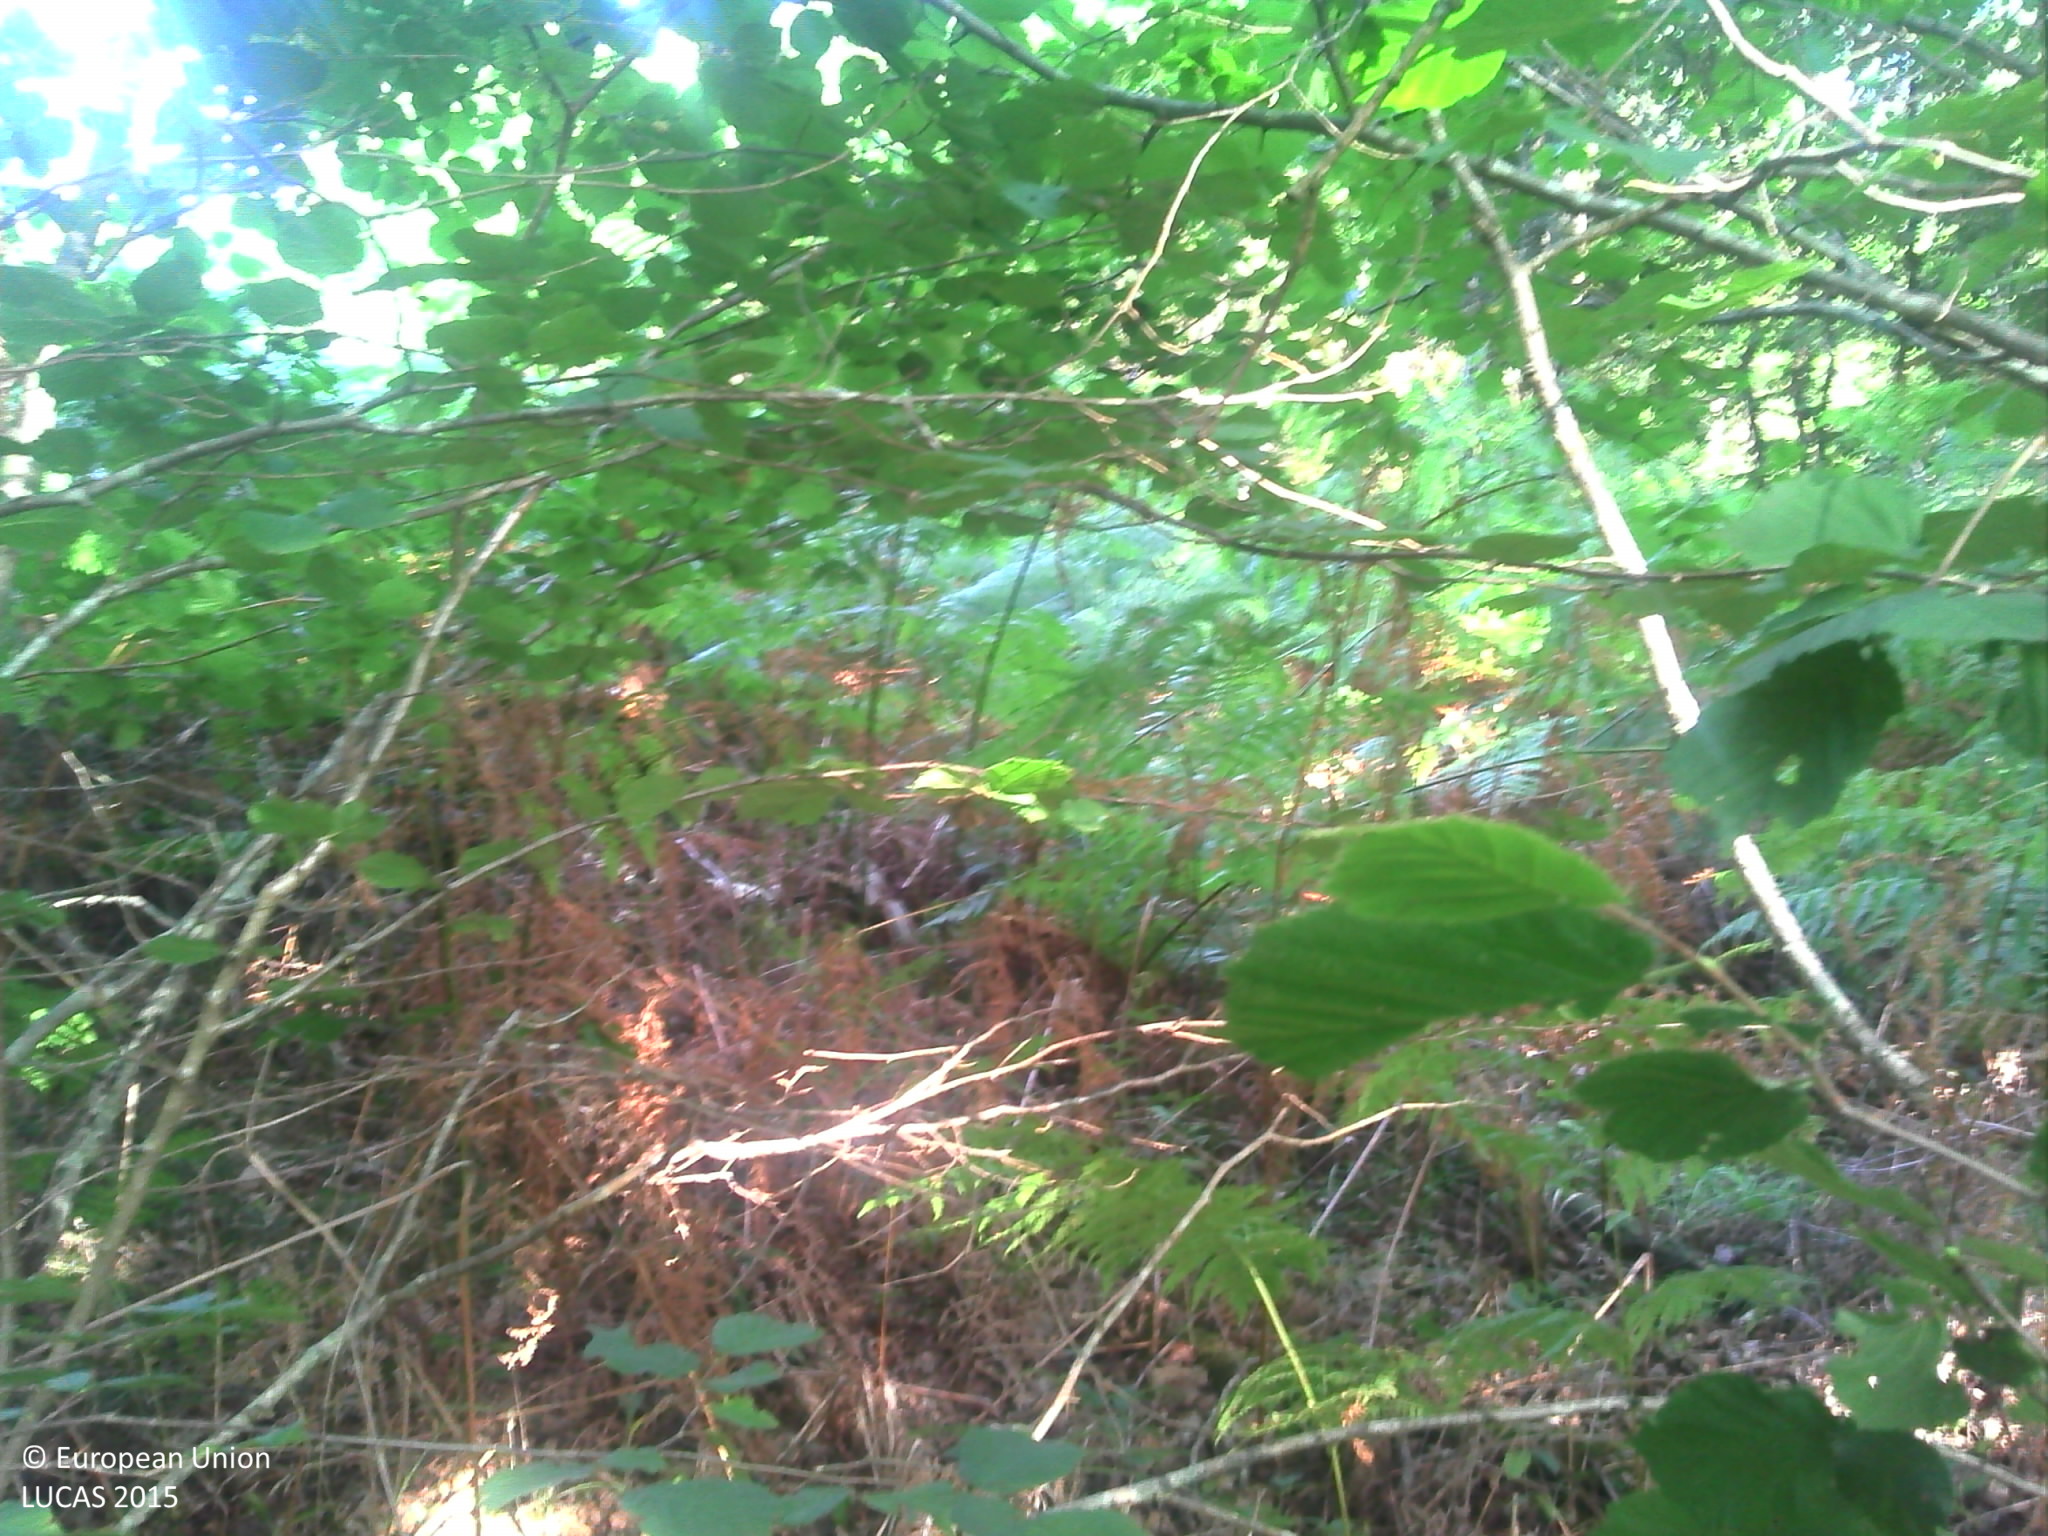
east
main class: Woodland
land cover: Broadleaved woodland
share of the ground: > 75 %
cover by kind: broadleaved forest trees 95 %, coniferous forest trees 5 %
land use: Semi-natural and natural areas not in use
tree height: > 5 m
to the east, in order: Broadleaved woodland; Tracks; Broadleaved woodland; Tracks; Broadleaved woodland; Tracks; Inland fresh water bodies
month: August
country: FR
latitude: 46.0978
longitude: 0.9980
